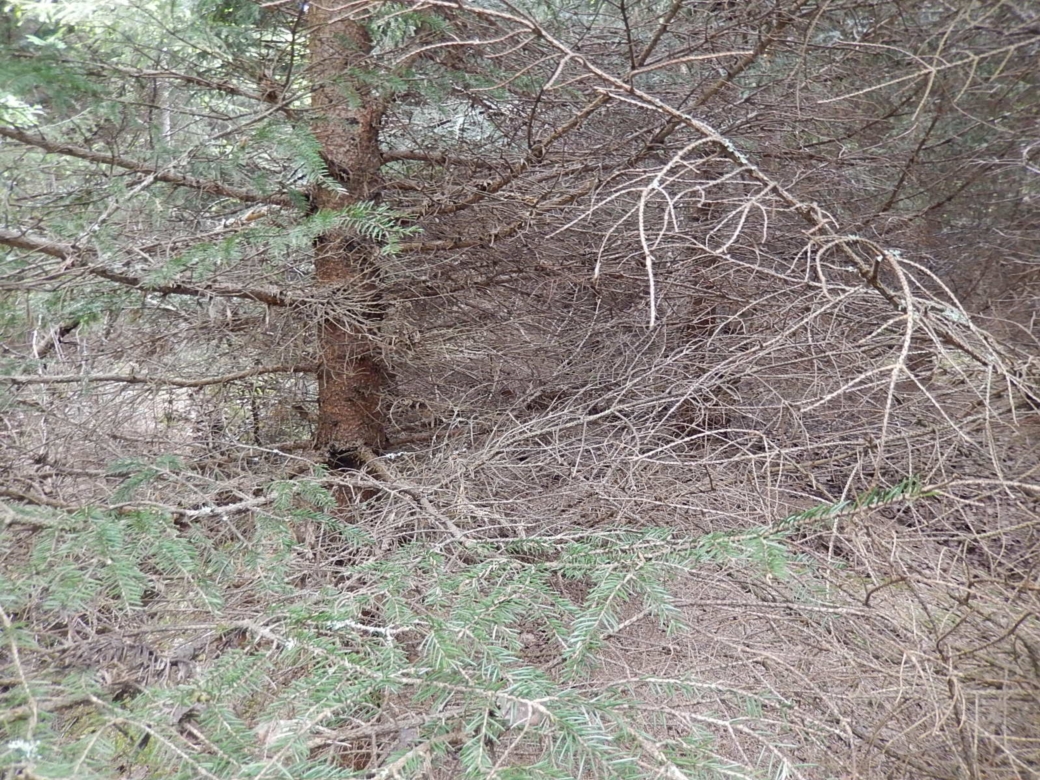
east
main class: Woodland
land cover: Spruce dominated mixed woodland
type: boreal forest
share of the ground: > 75 %
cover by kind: coniferous forest trees 55 %, broadleaved forest trees 40 %, herbaceous plants 5 %
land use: Forestry
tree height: > 5 m
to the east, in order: Spruce dominated mixed woodland; Ditches and canals; Spruce dominated mixed woodland; Pine dominated coniferous woodland; Other coniferous woodland
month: June
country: FI
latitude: 61.8948
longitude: 21.5220
